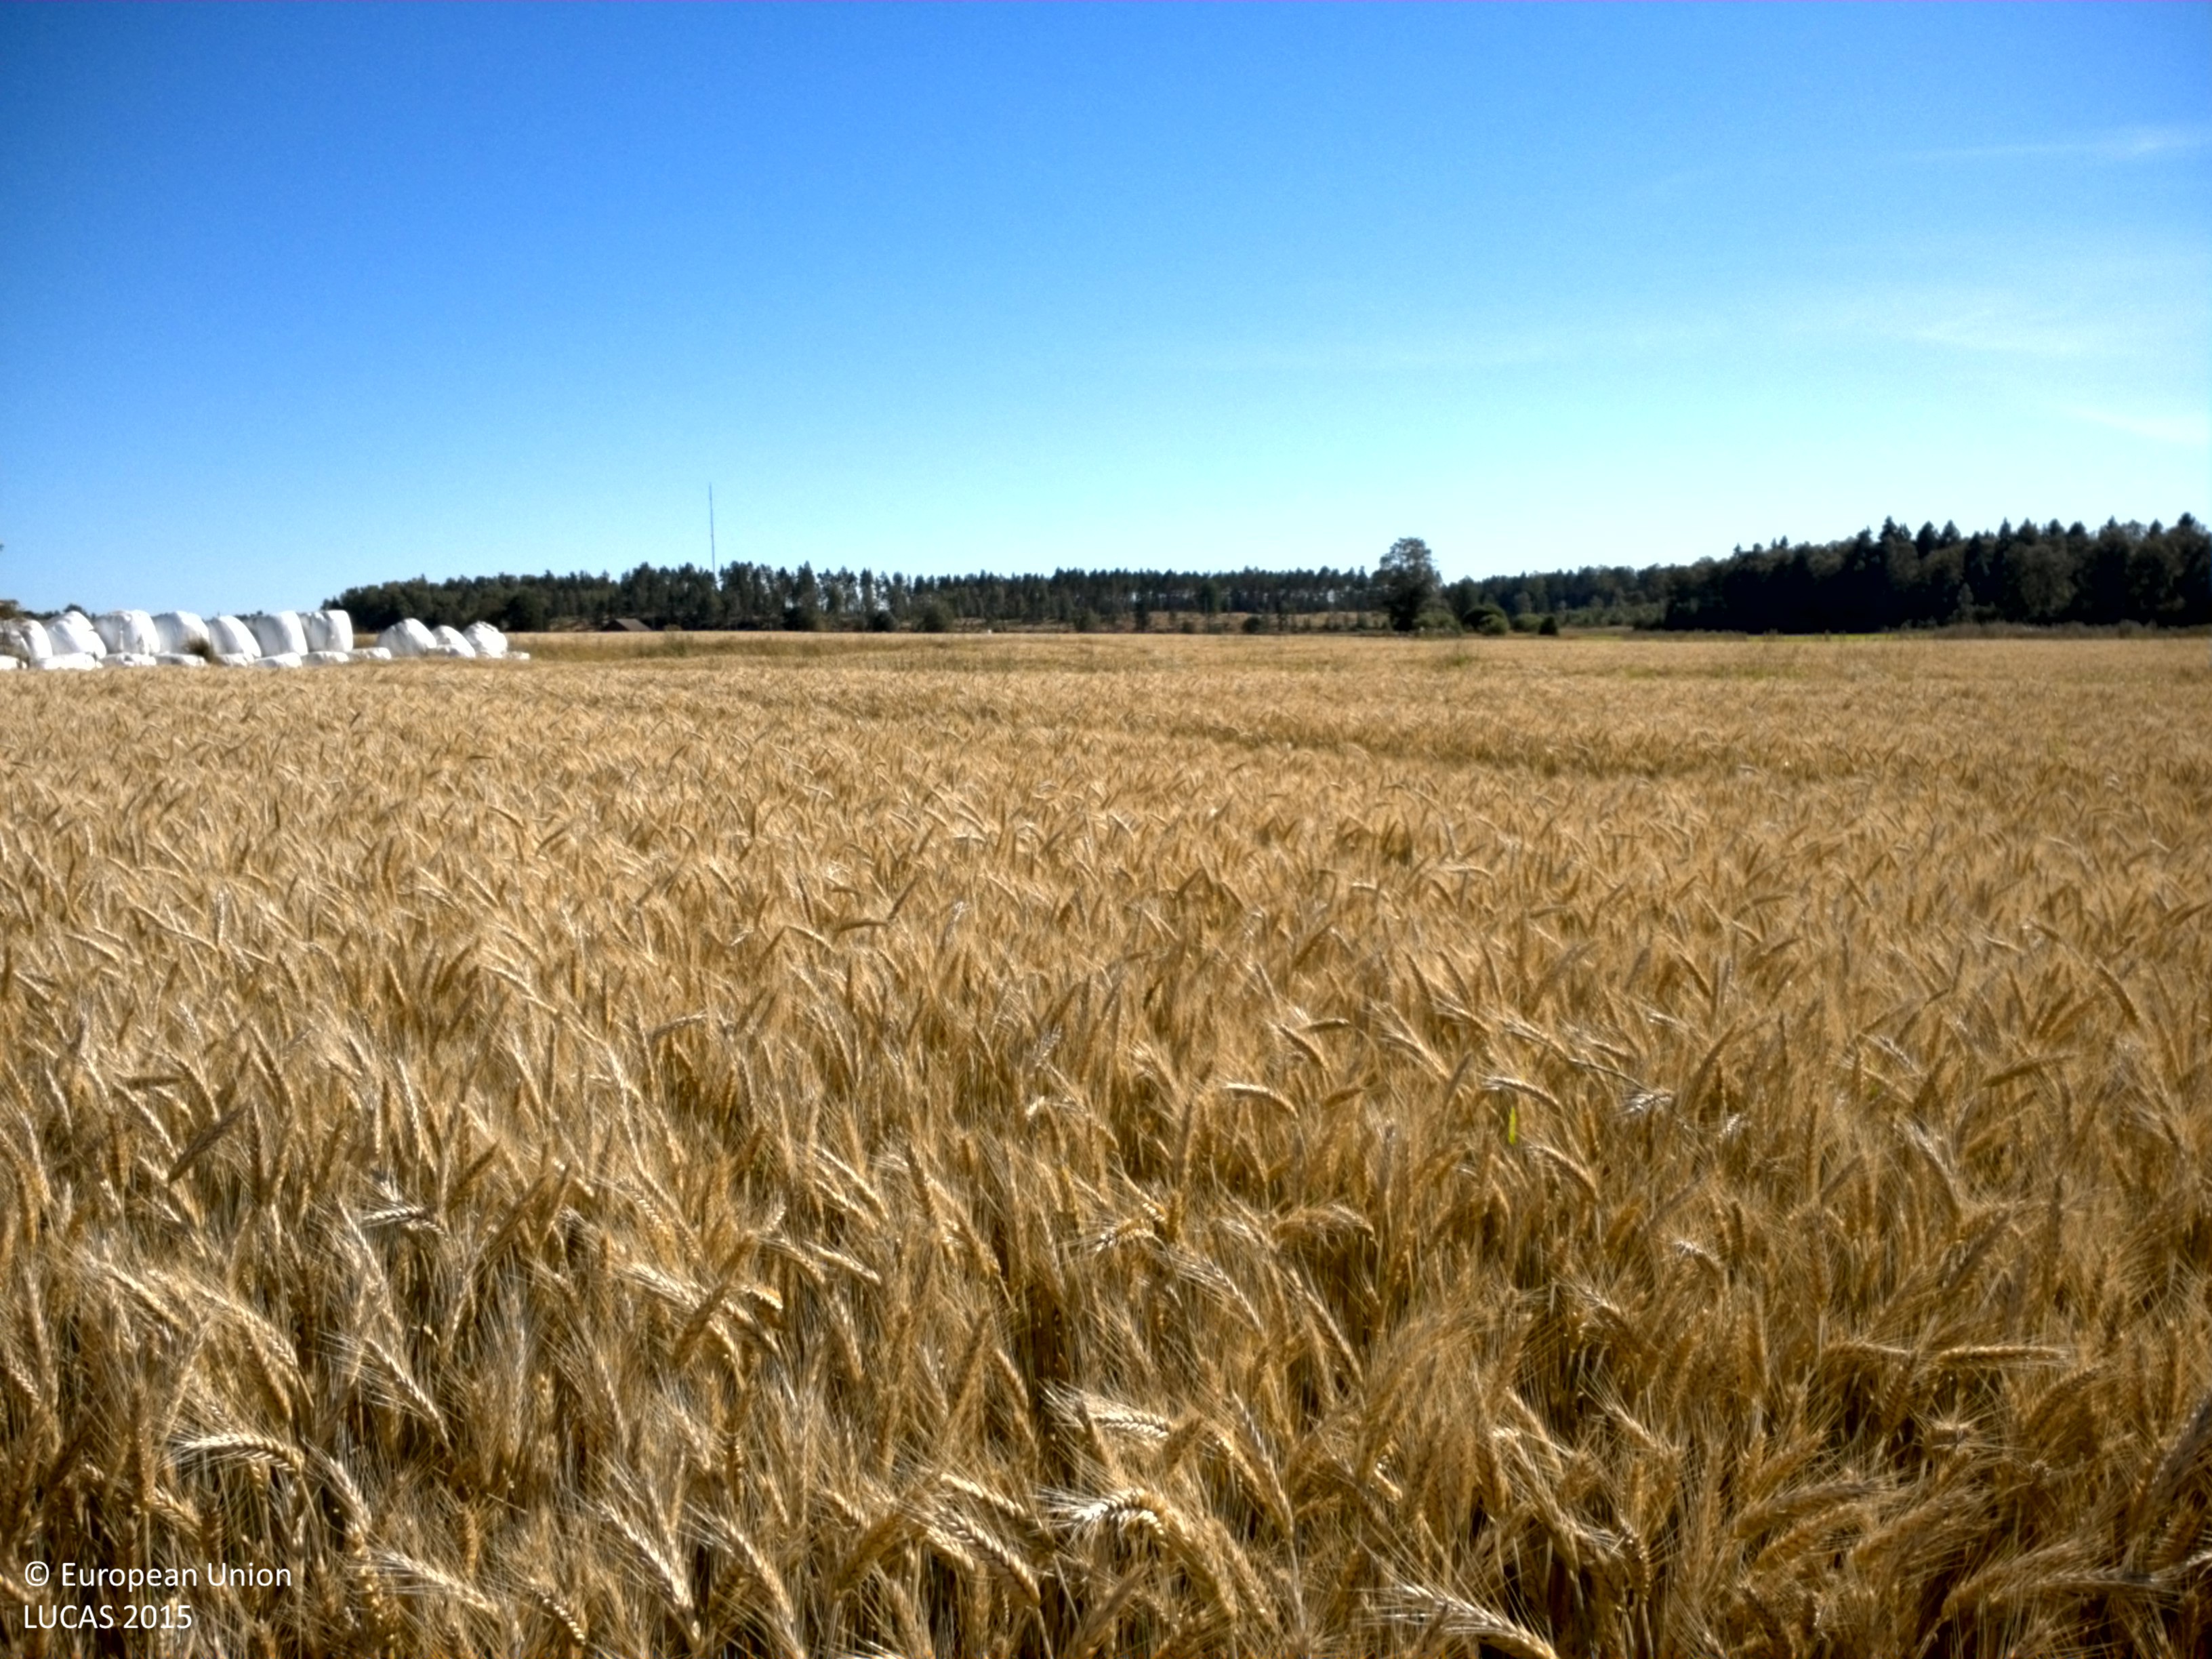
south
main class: Cropland
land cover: Rye
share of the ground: > 75 %
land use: Agriculture (excluding fallow land and kitchen gardens)
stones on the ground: < 10 %
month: August
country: SE
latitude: 60.1677
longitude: 17.0374
